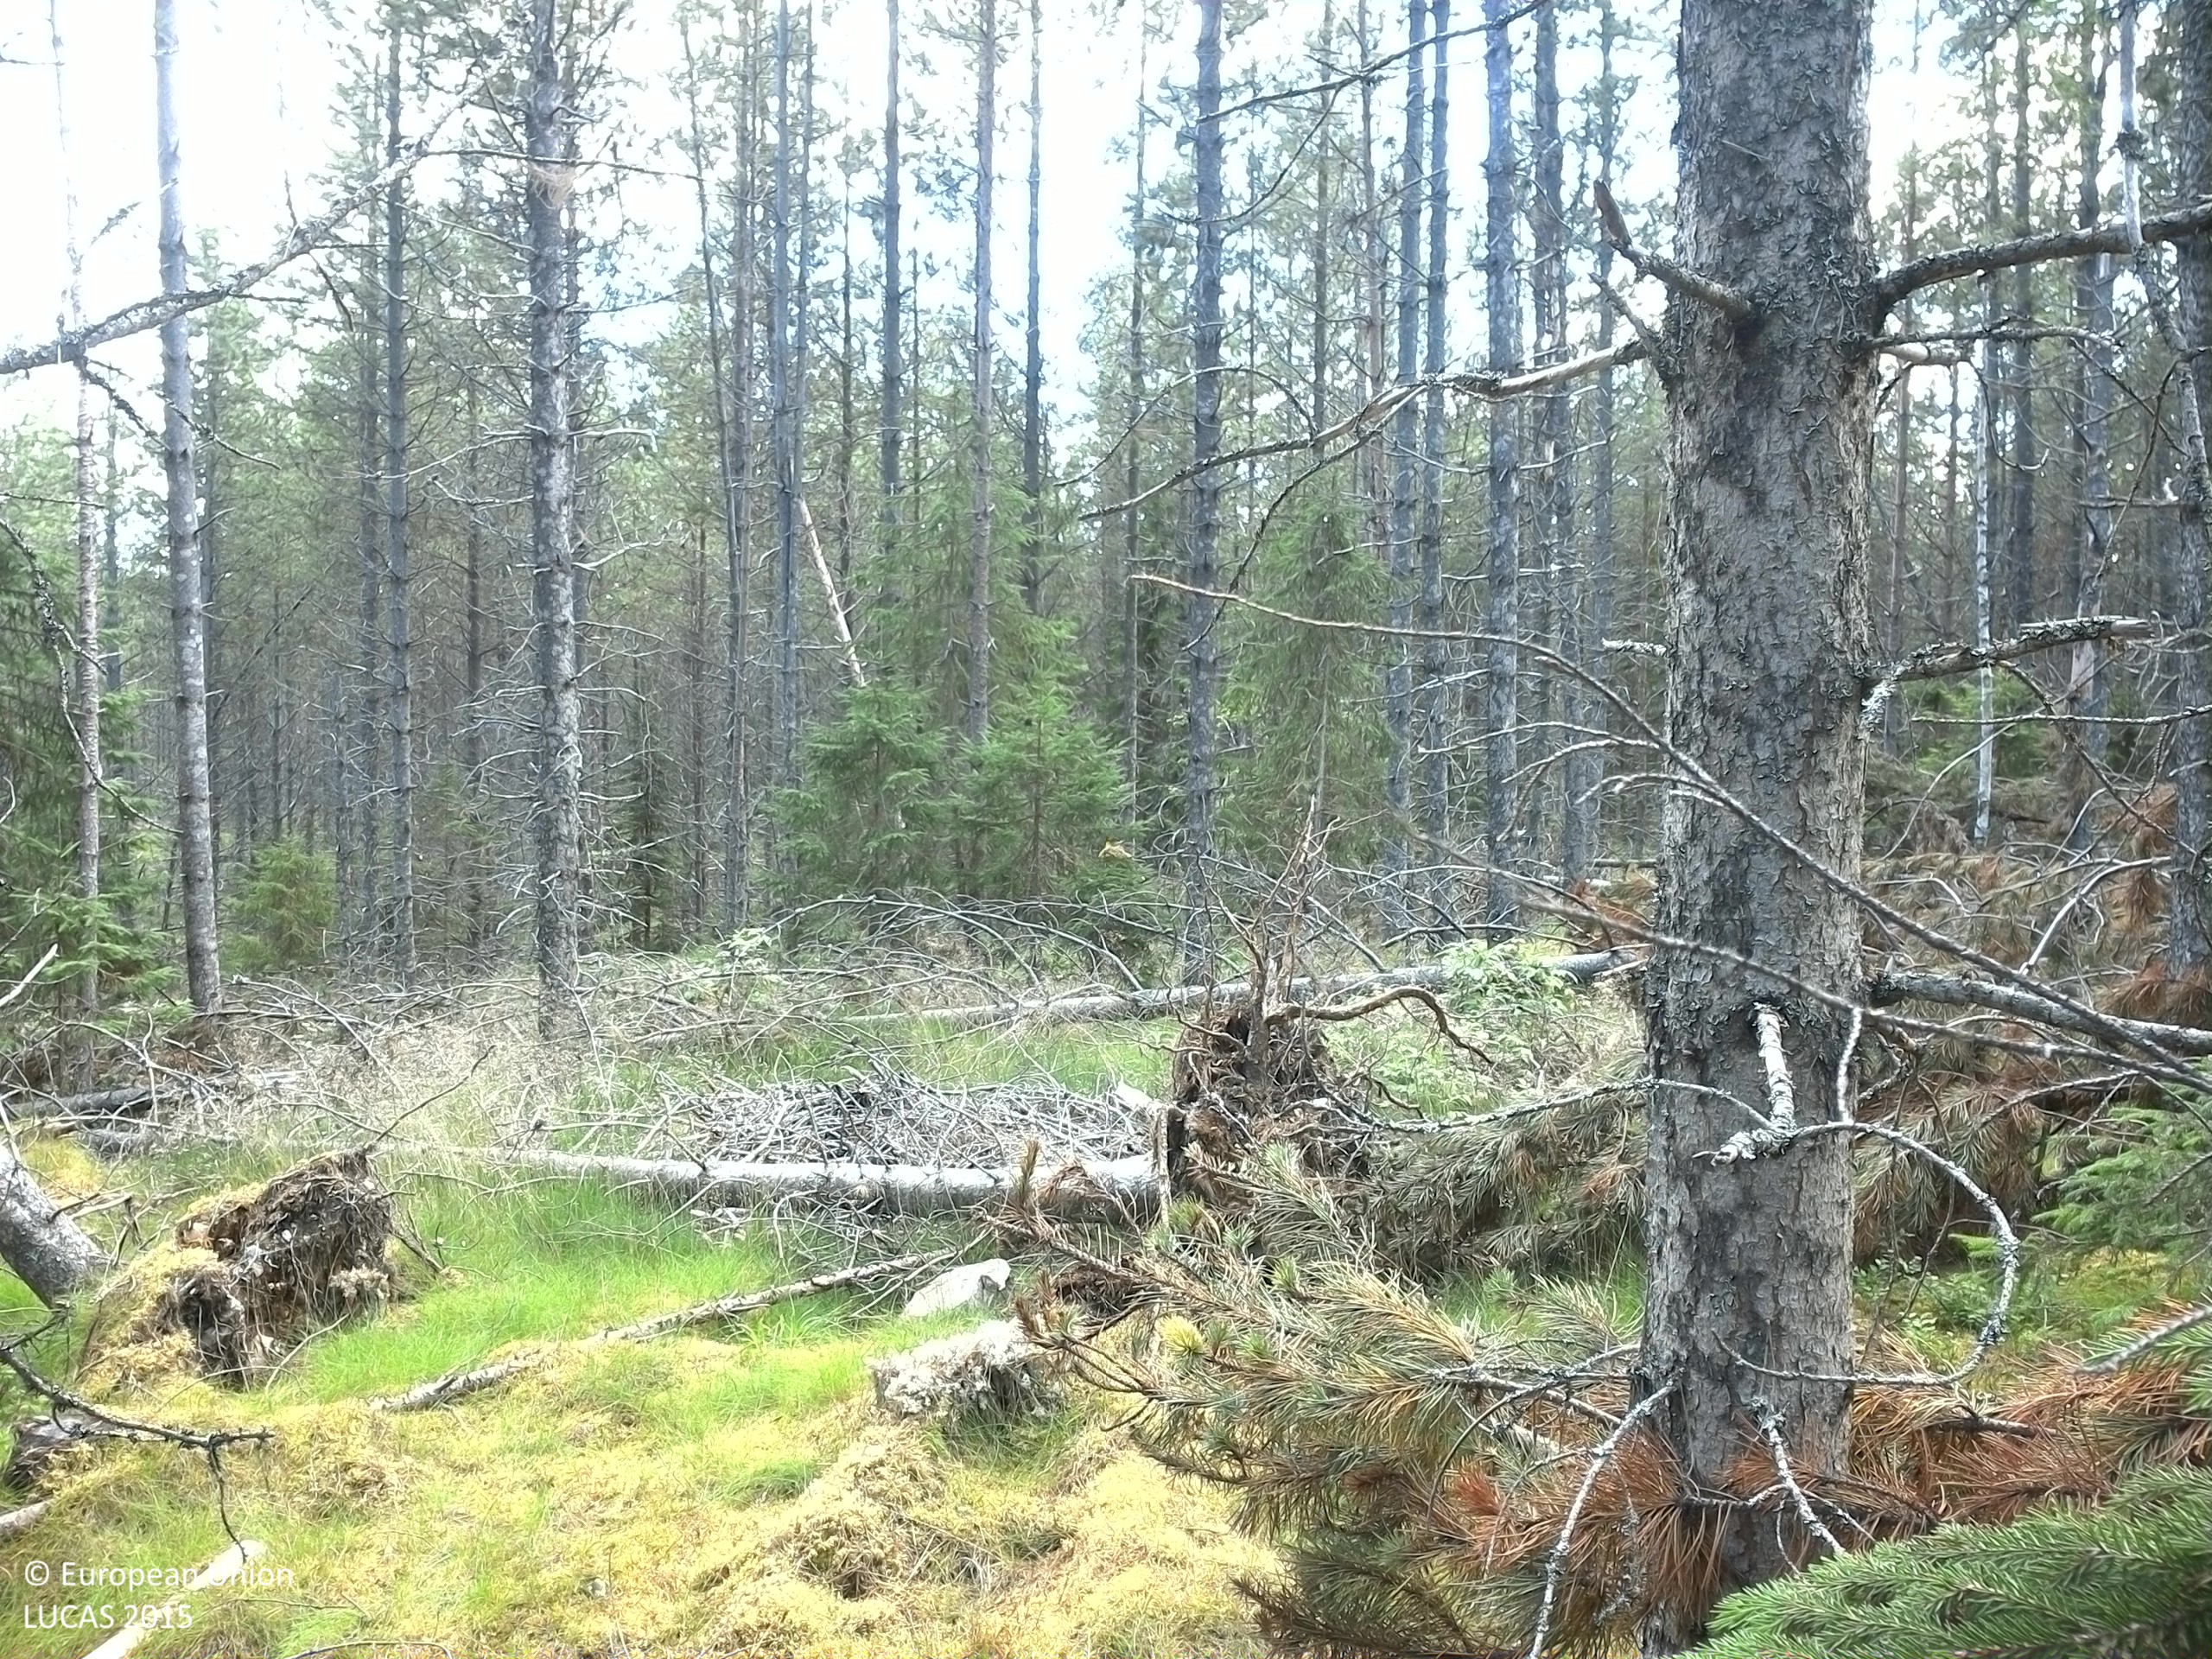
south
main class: Woodland
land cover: Pine dominated coniferous woodland
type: exotic forest
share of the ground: > 75 %
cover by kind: coniferous forest trees 75 %, herbaceous plants 10 %, lichens and mosses 10 %, shrubs 5 %
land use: Forestry
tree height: > 5 m
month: August
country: SE
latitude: 62.9034
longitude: 16.5694
